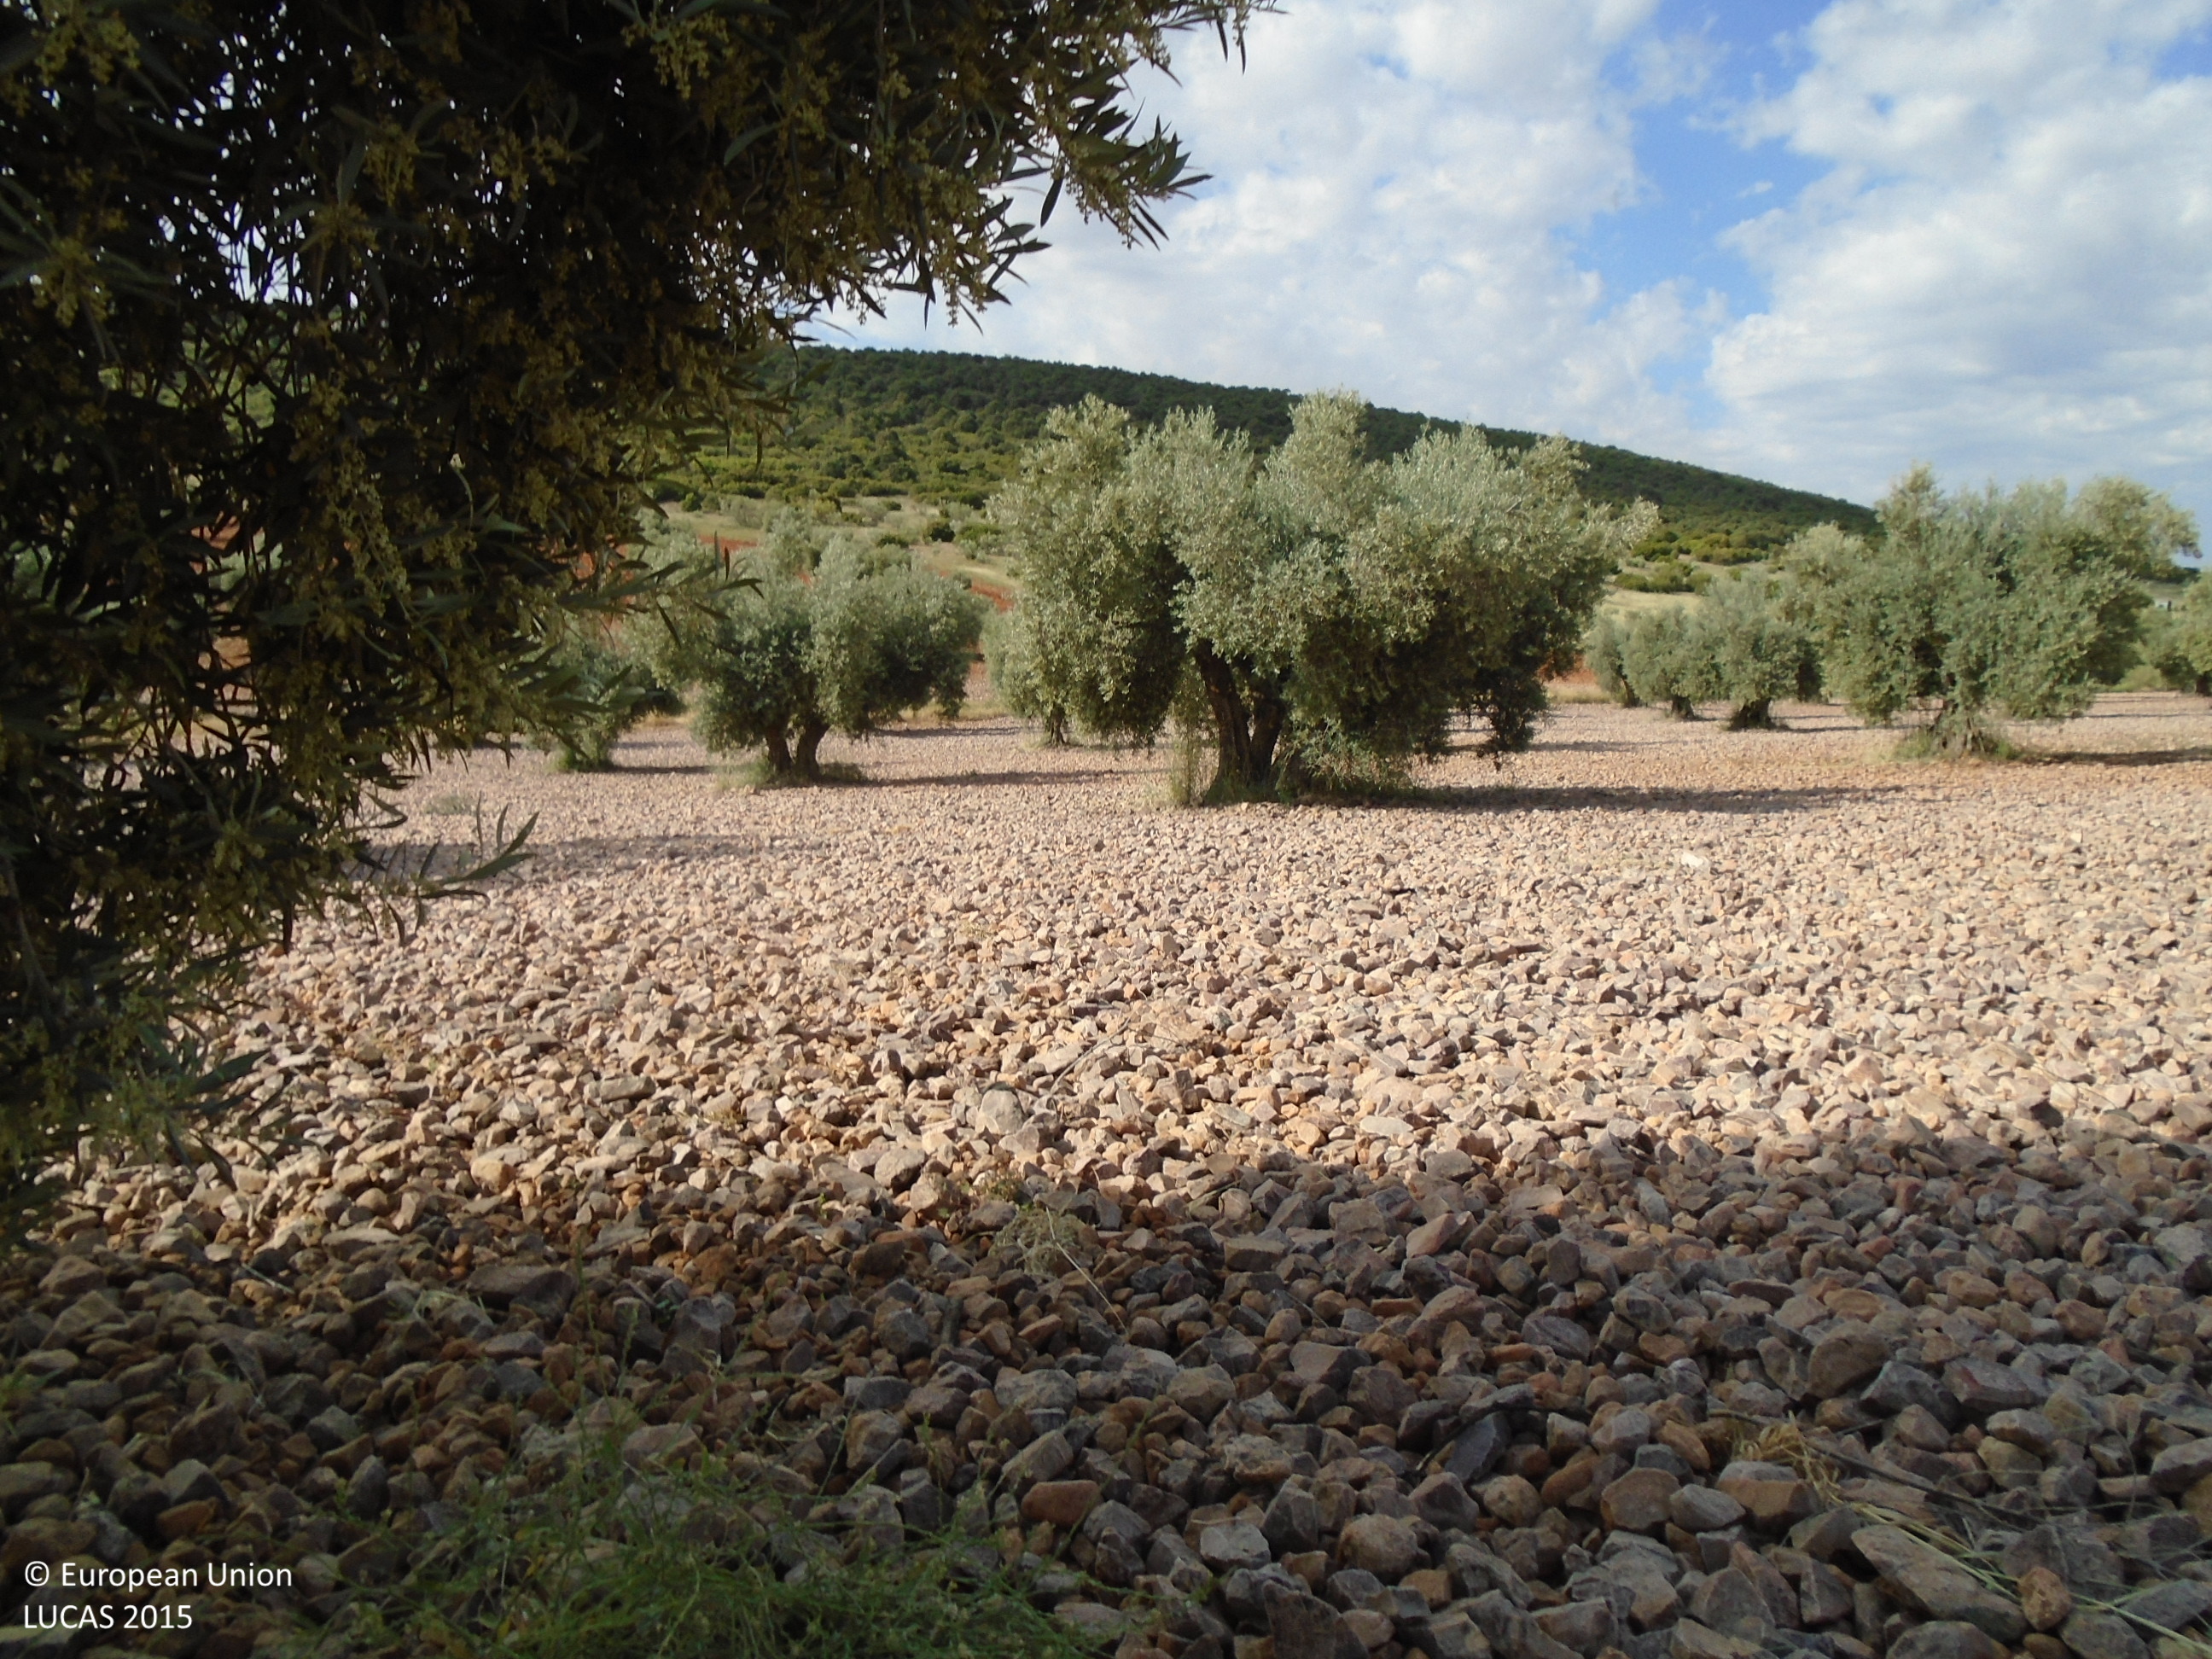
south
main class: Cropland
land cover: Olive groves
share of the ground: 10 - 25 %
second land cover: Other bare soil
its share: > 75 %
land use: Agriculture (excluding fallow land and kitchen gardens)
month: May
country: ES
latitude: 39.5900
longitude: -3.7317
